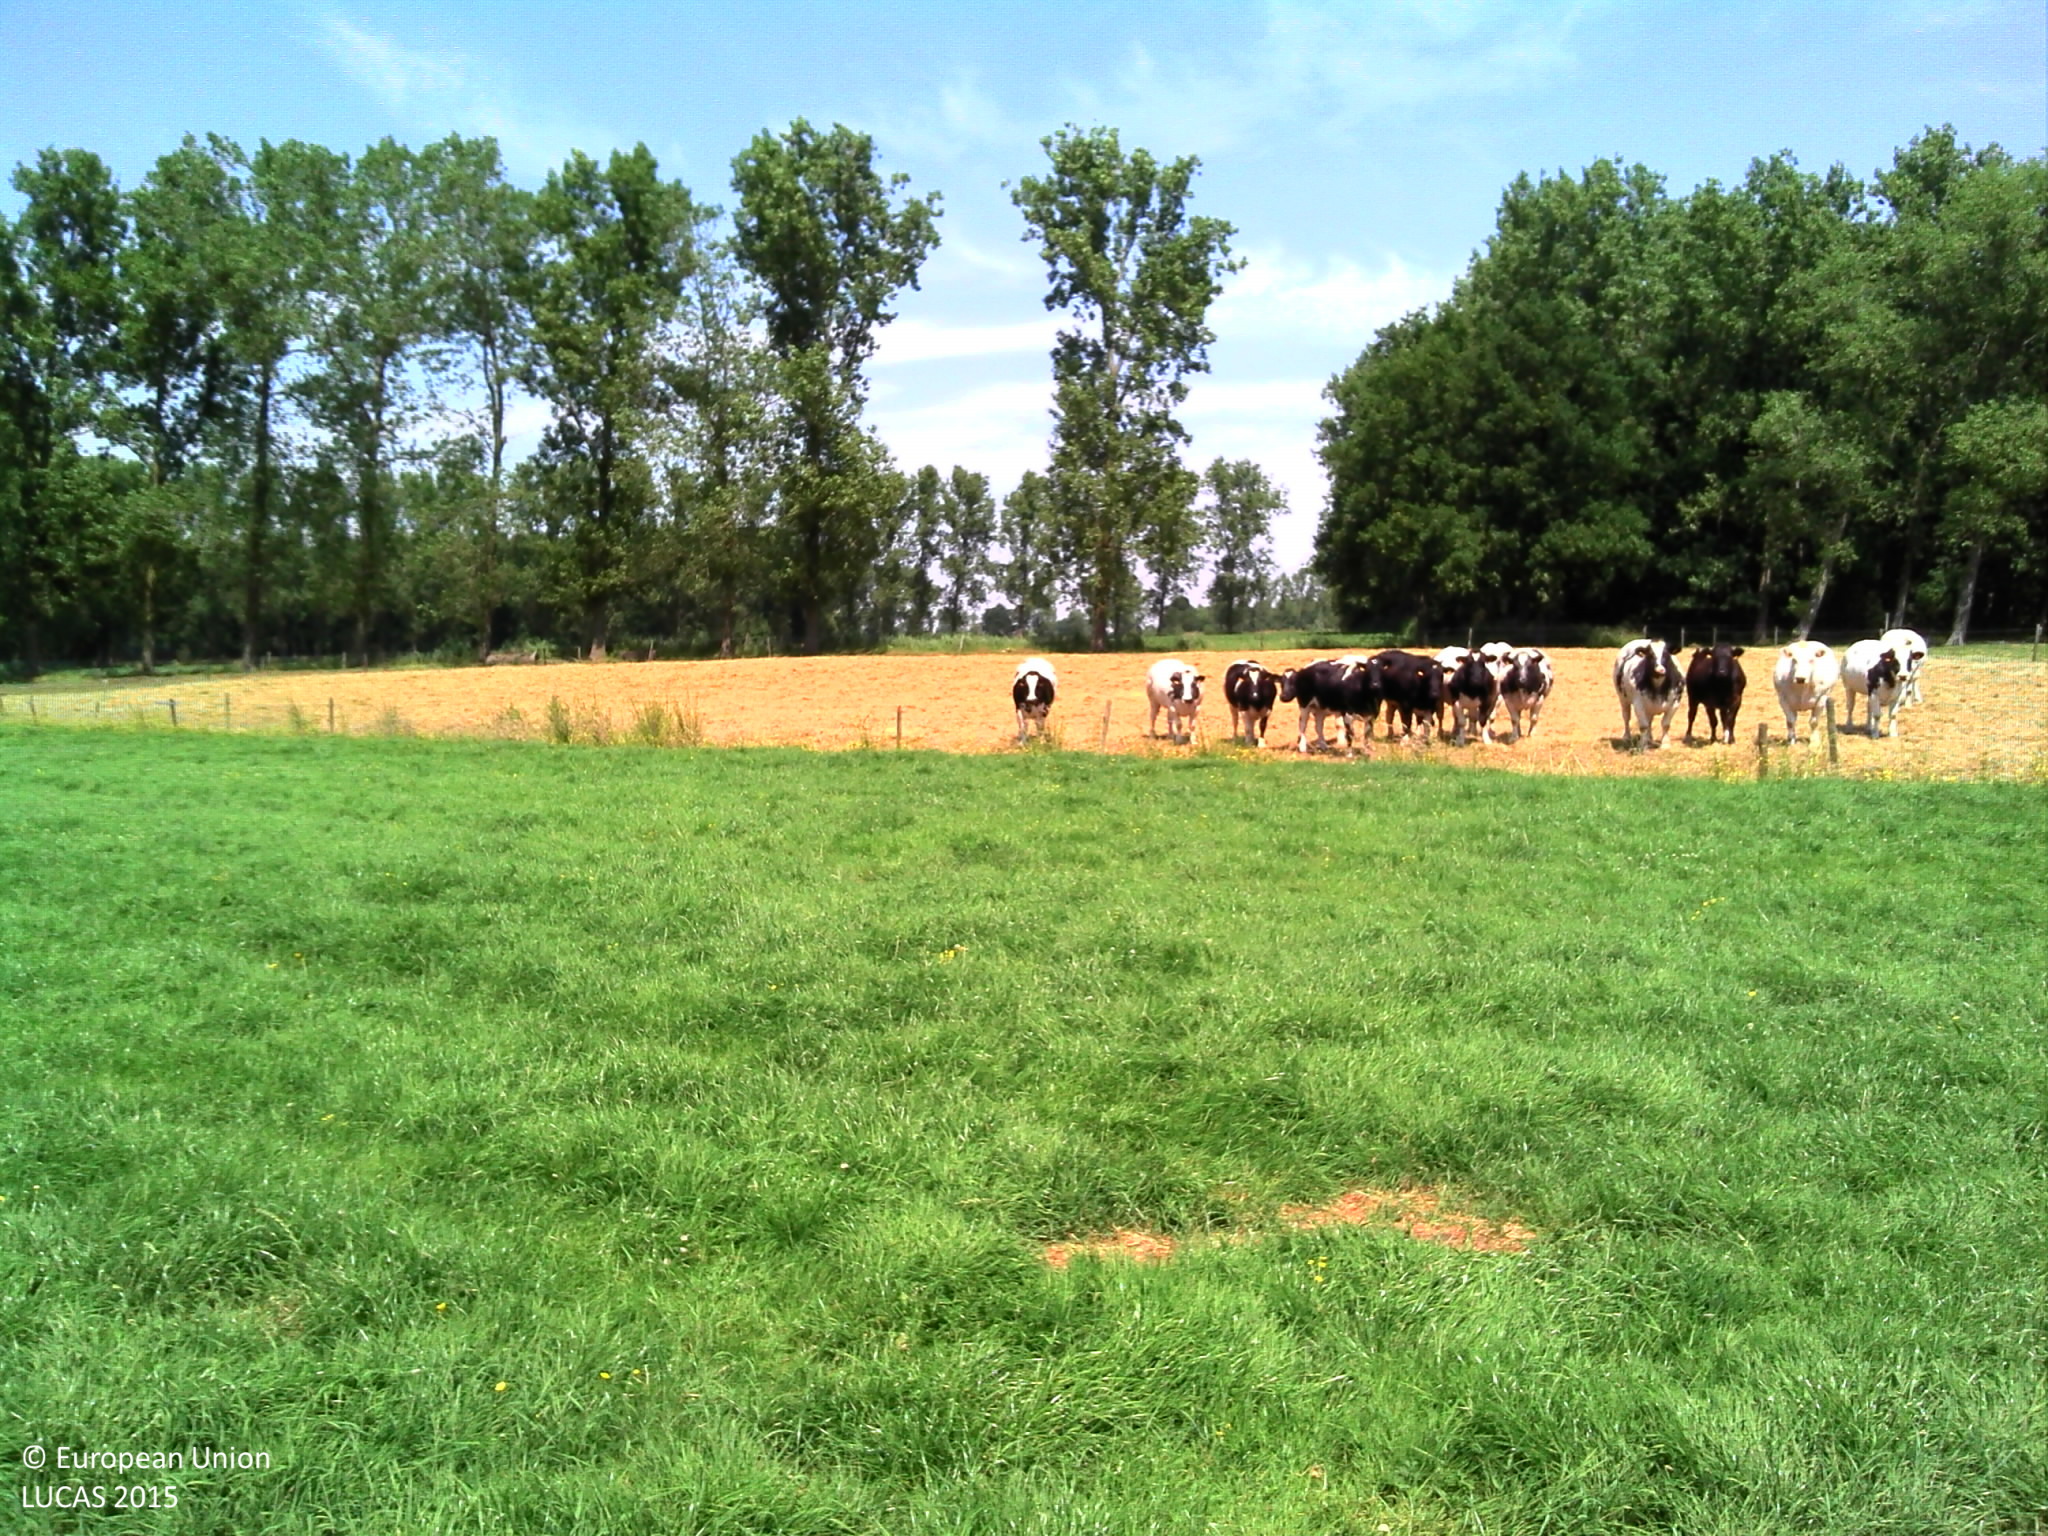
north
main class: Grassland
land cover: Grassland without tree/shrub cover
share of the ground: > 75 %
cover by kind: herbaceous plants 100 %
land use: Agriculture (excluding fallow land and kitchen gardens)
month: July
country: BE
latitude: 51.1672
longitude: 3.4276
